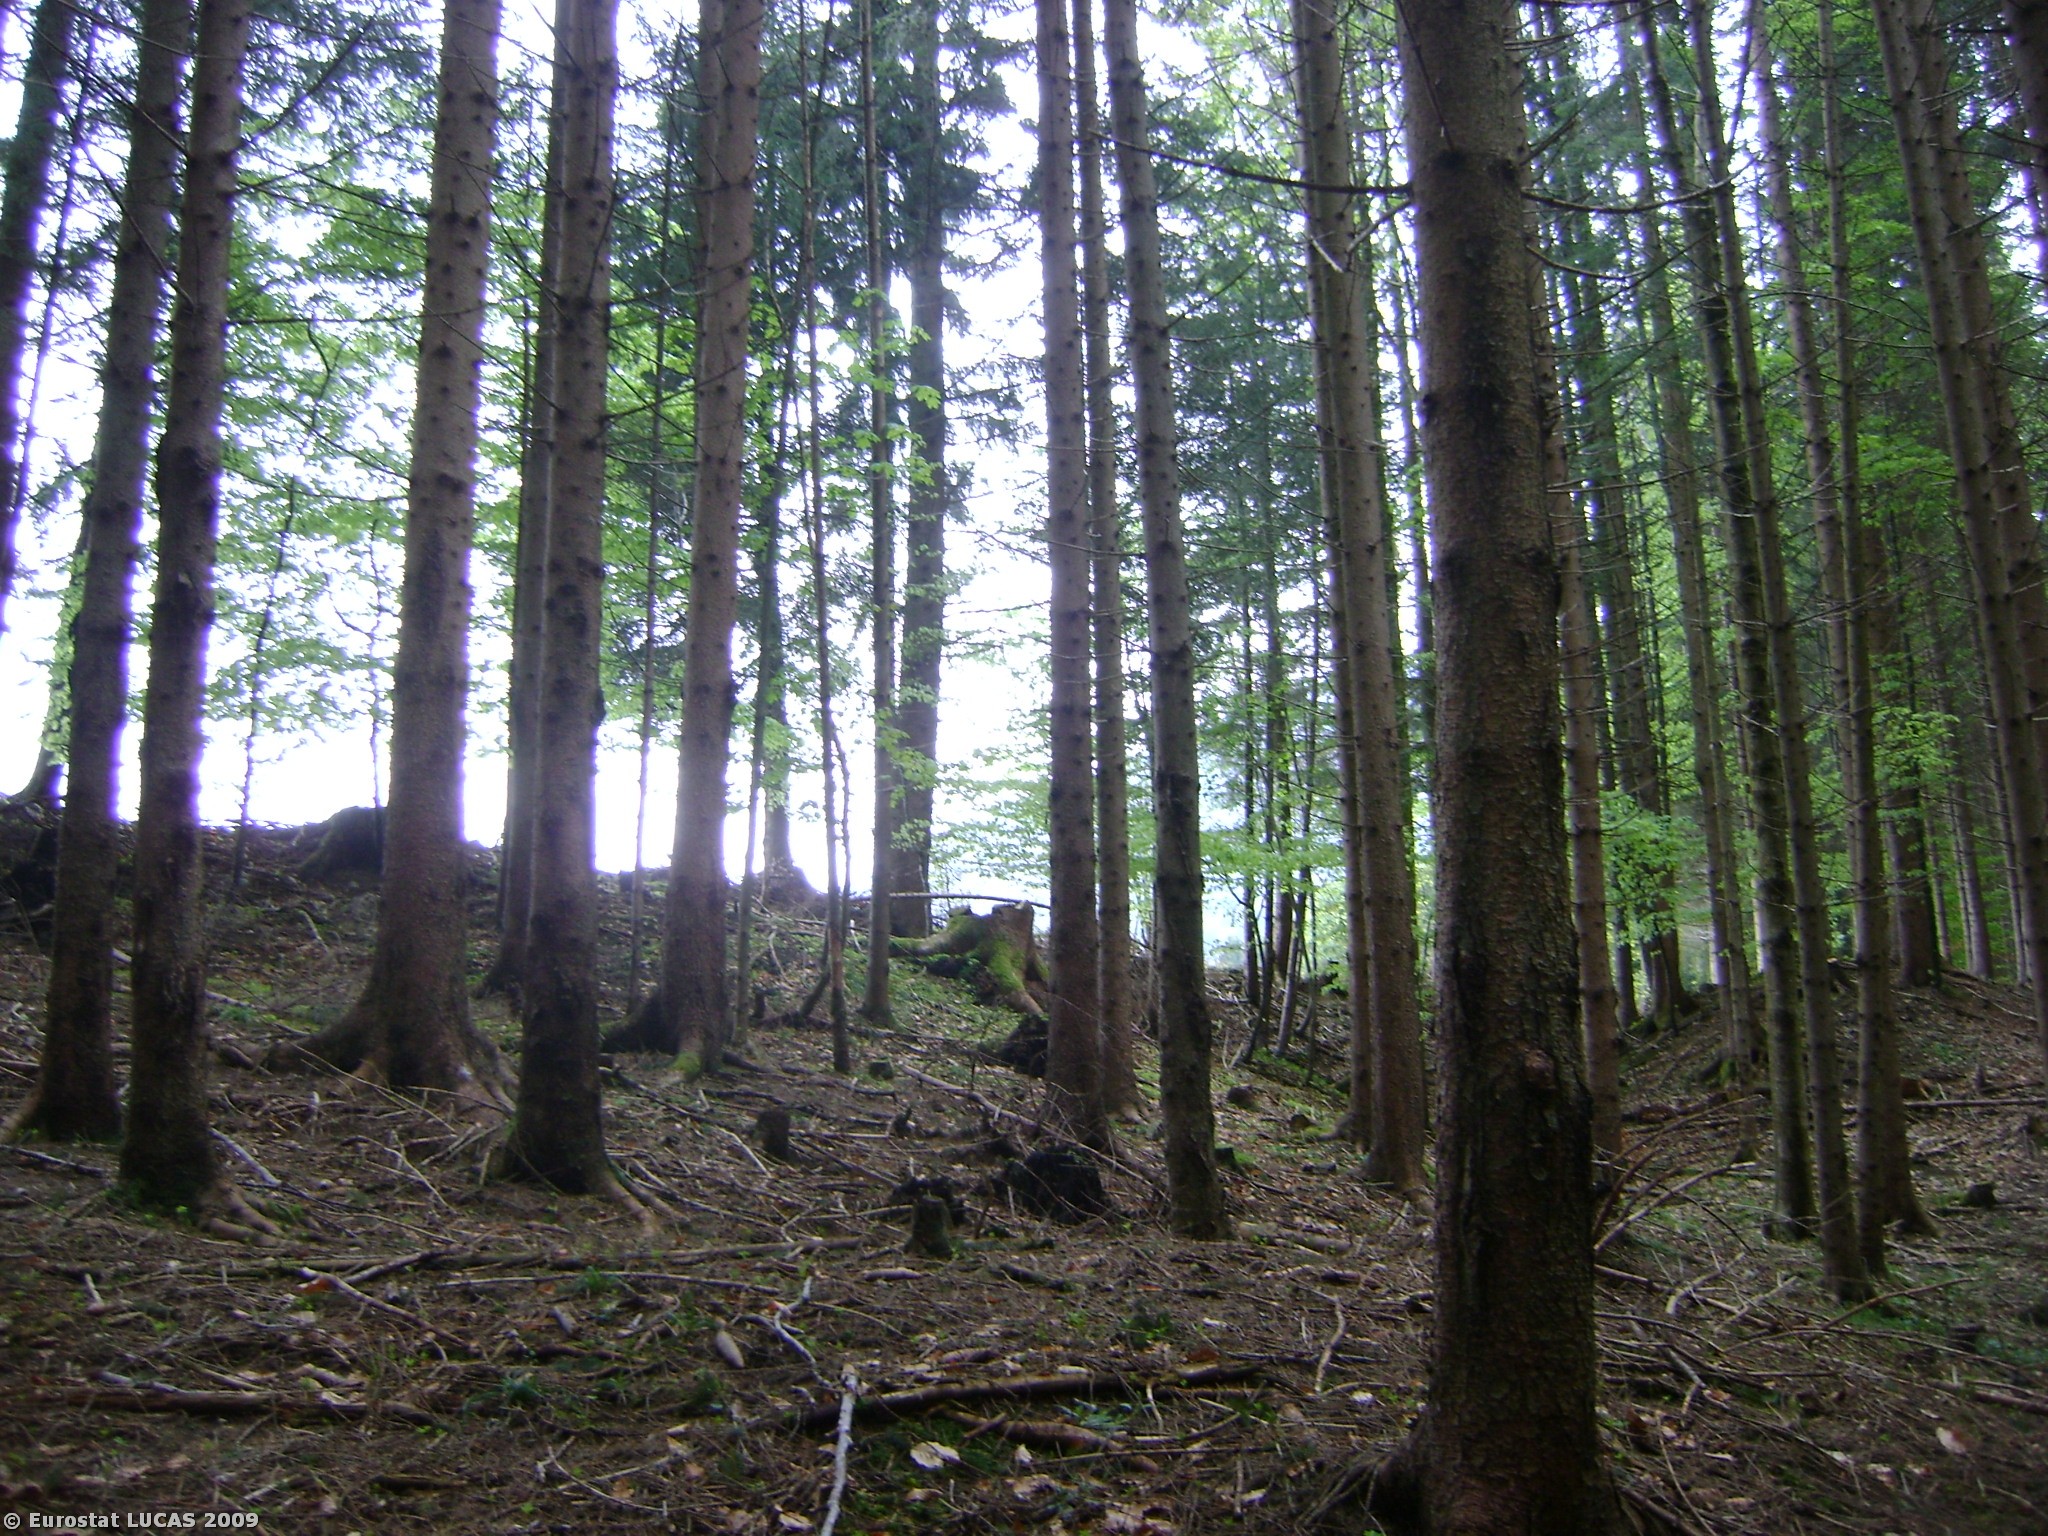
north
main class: Woodland
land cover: Mixed woodland
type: hemiboreal forest and nemoral coniferous forest and mixed broadleaved-coniferous forest
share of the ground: > 75 %
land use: Forestry
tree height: > 5 m
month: May
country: AT
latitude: 47.7805
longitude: 13.2151
